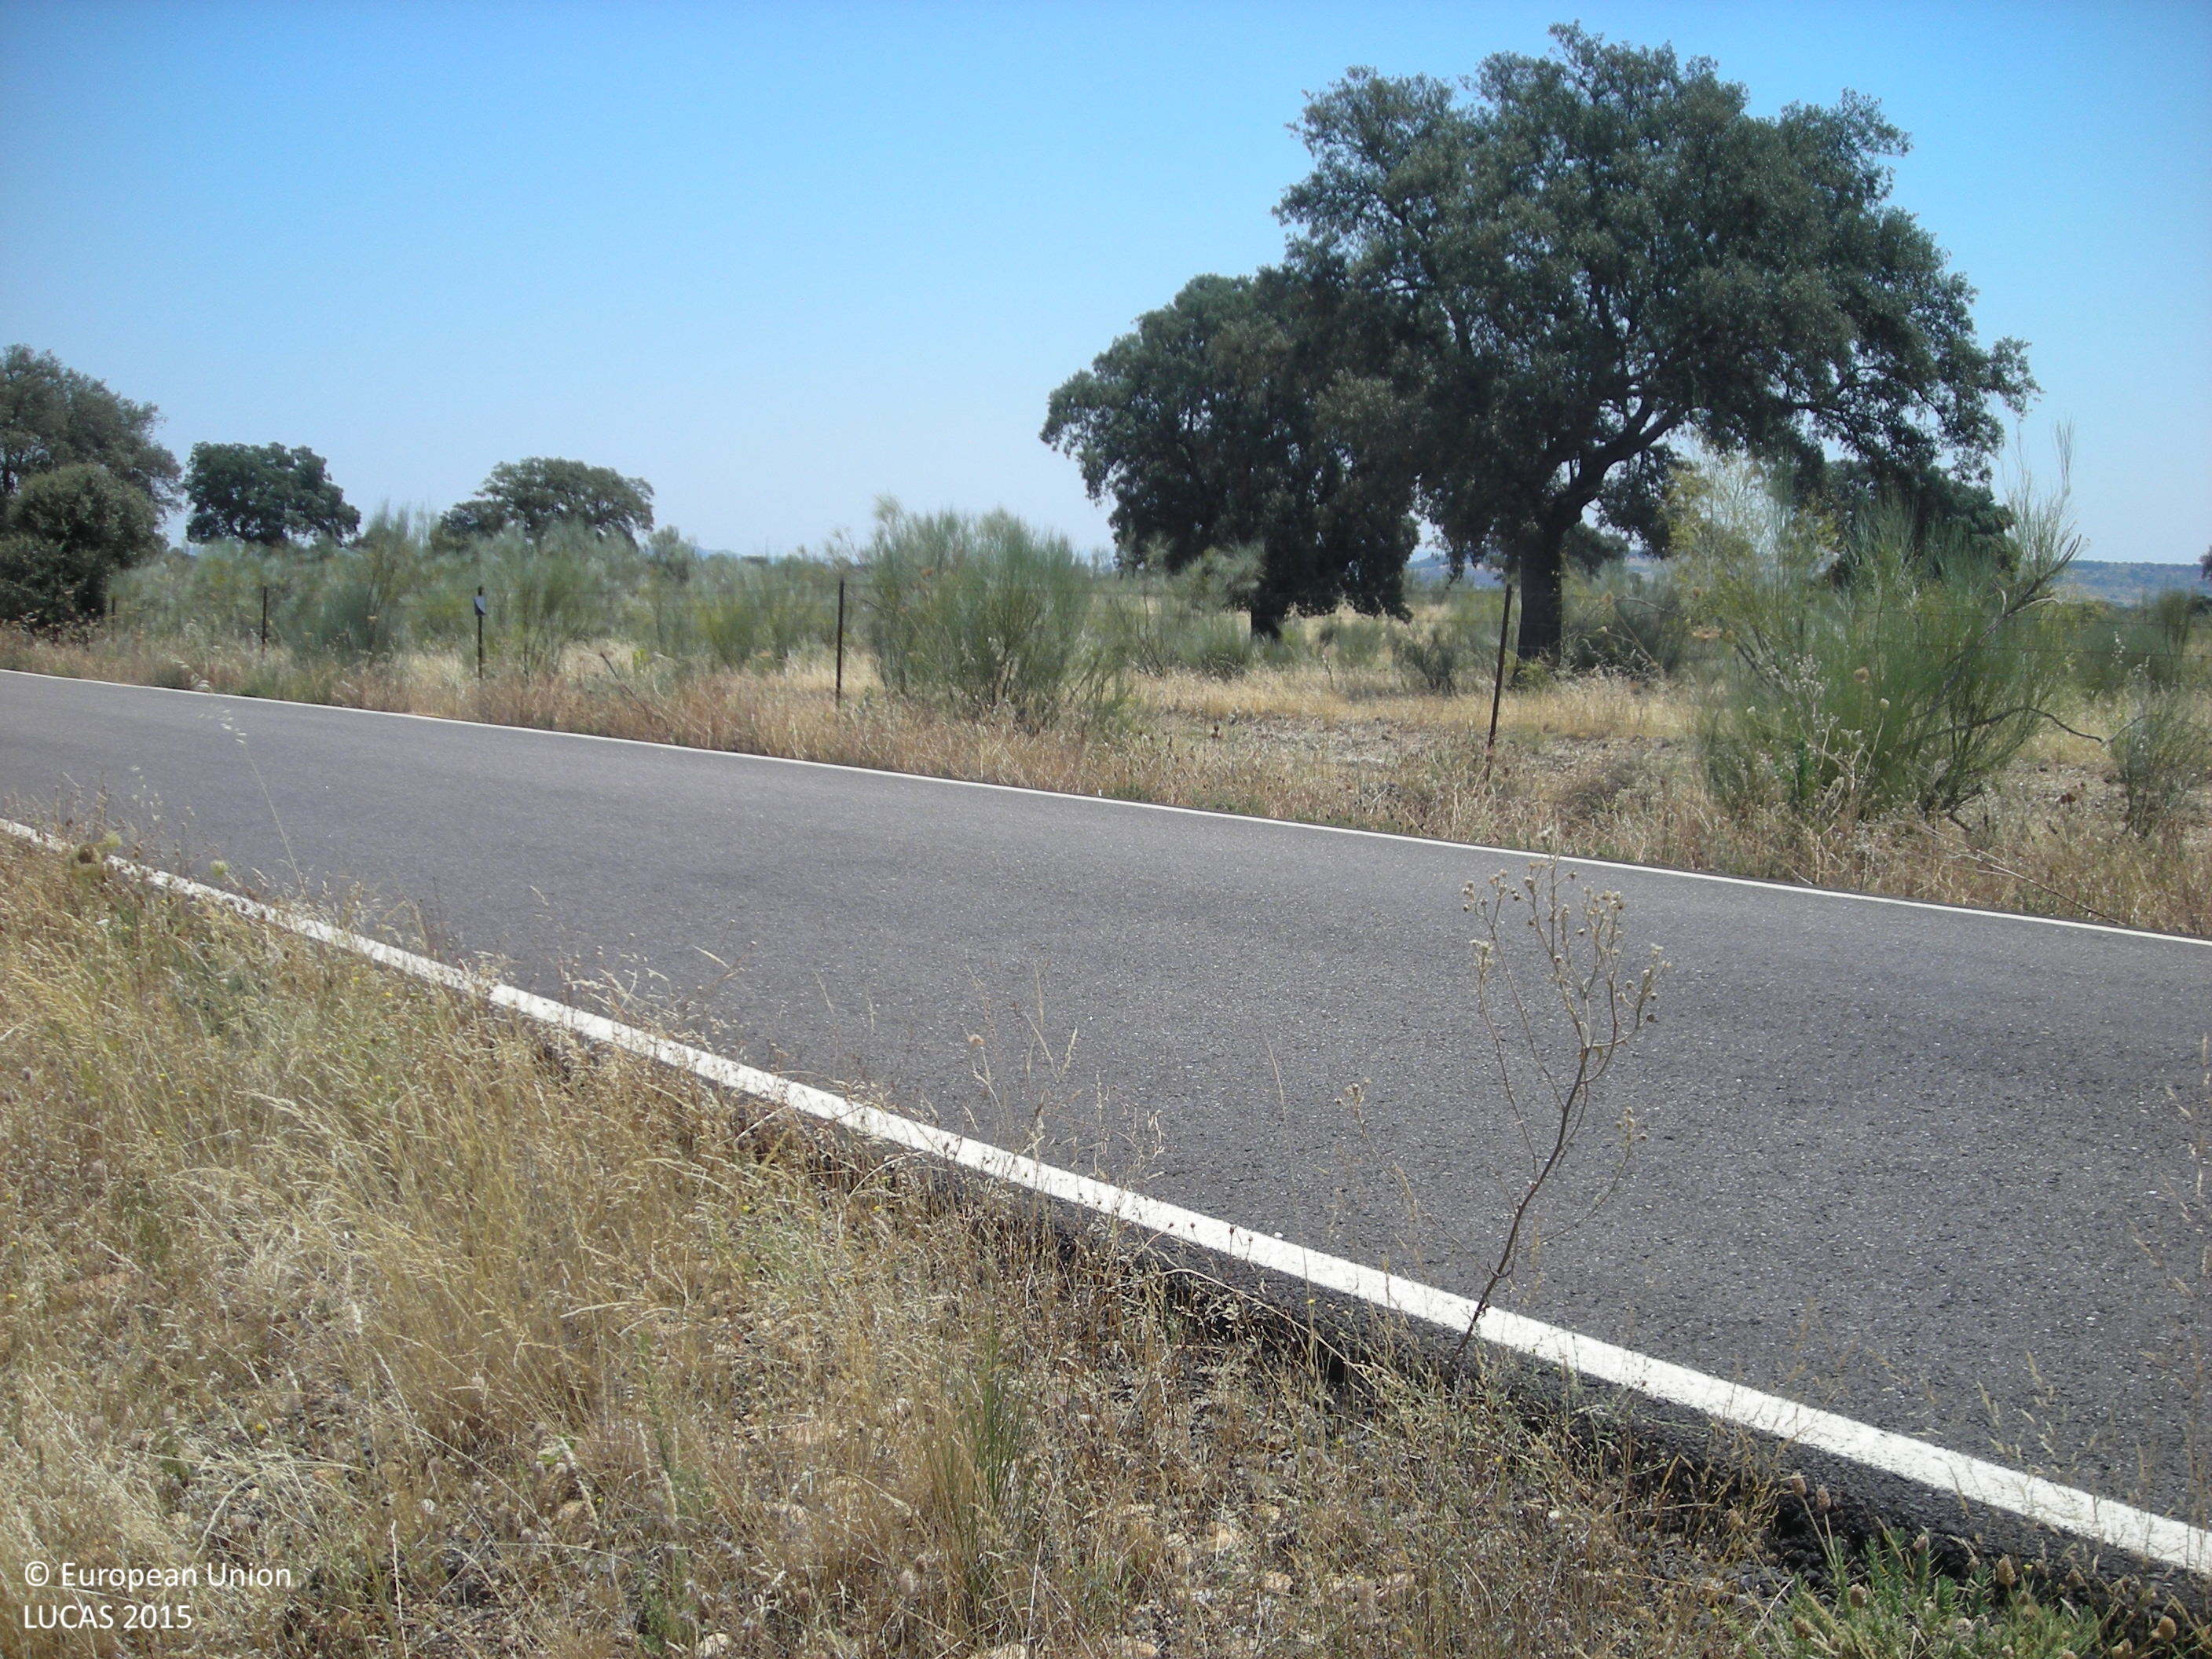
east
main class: Grassland
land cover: Grassland with sparse tree/shrub cover
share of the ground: 50 - 75 %
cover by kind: herbaceous plants 85 %, shrubs 10 %, broadleaved forest trees 5 %
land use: Semi-natural and natural areas not in use
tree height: > 5 m
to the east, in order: Grassland with sparse tree/shrub cover; Paved roads, cycling and walking lanes; Grassland with sparse tree/shrub cover; Fences; Other bare soil; Grassland with sparse tree/shrub cover; Tracks; Grassland with sparse tree/shrub cover
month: June
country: ES
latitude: 39.2377
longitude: -5.5618
